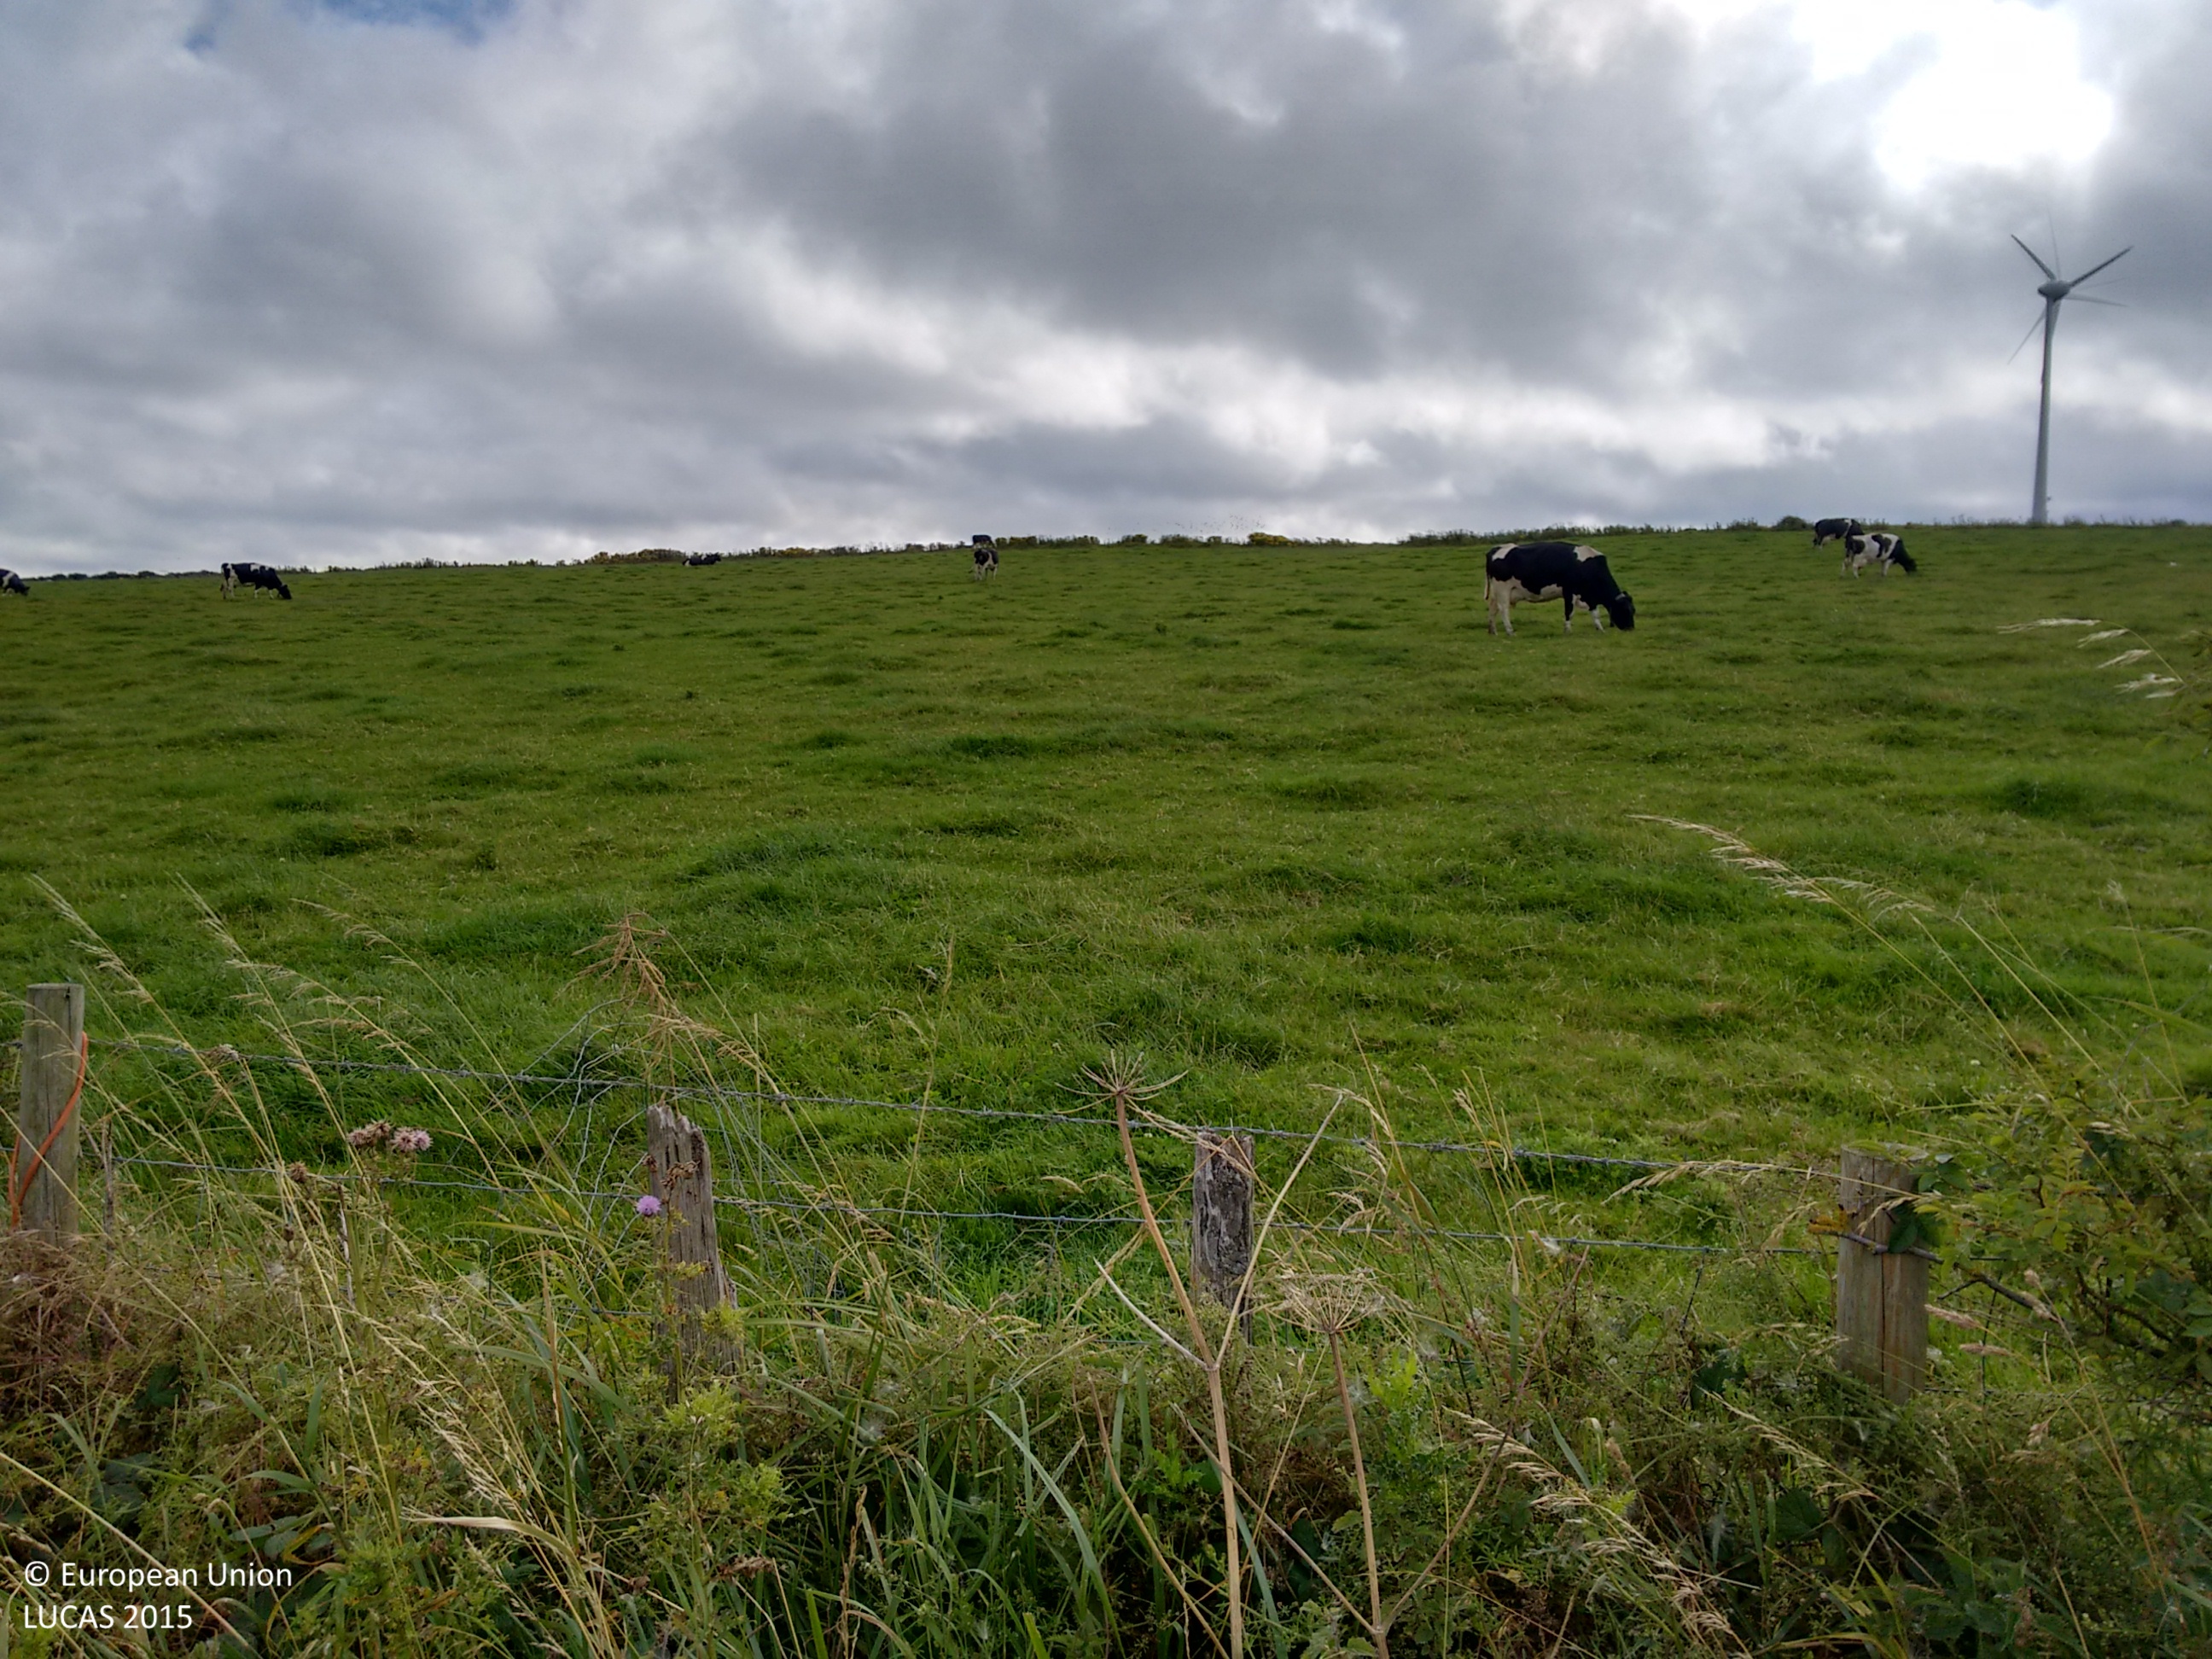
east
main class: Grassland
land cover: Grassland without tree/shrub cover
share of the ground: > 75 %
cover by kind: herbaceous plants 100 %
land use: Agriculture (excluding fallow land and kitchen gardens)
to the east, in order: Grassland without tree/shrub cover
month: August
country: GB
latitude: 54.6046
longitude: -3.5669
